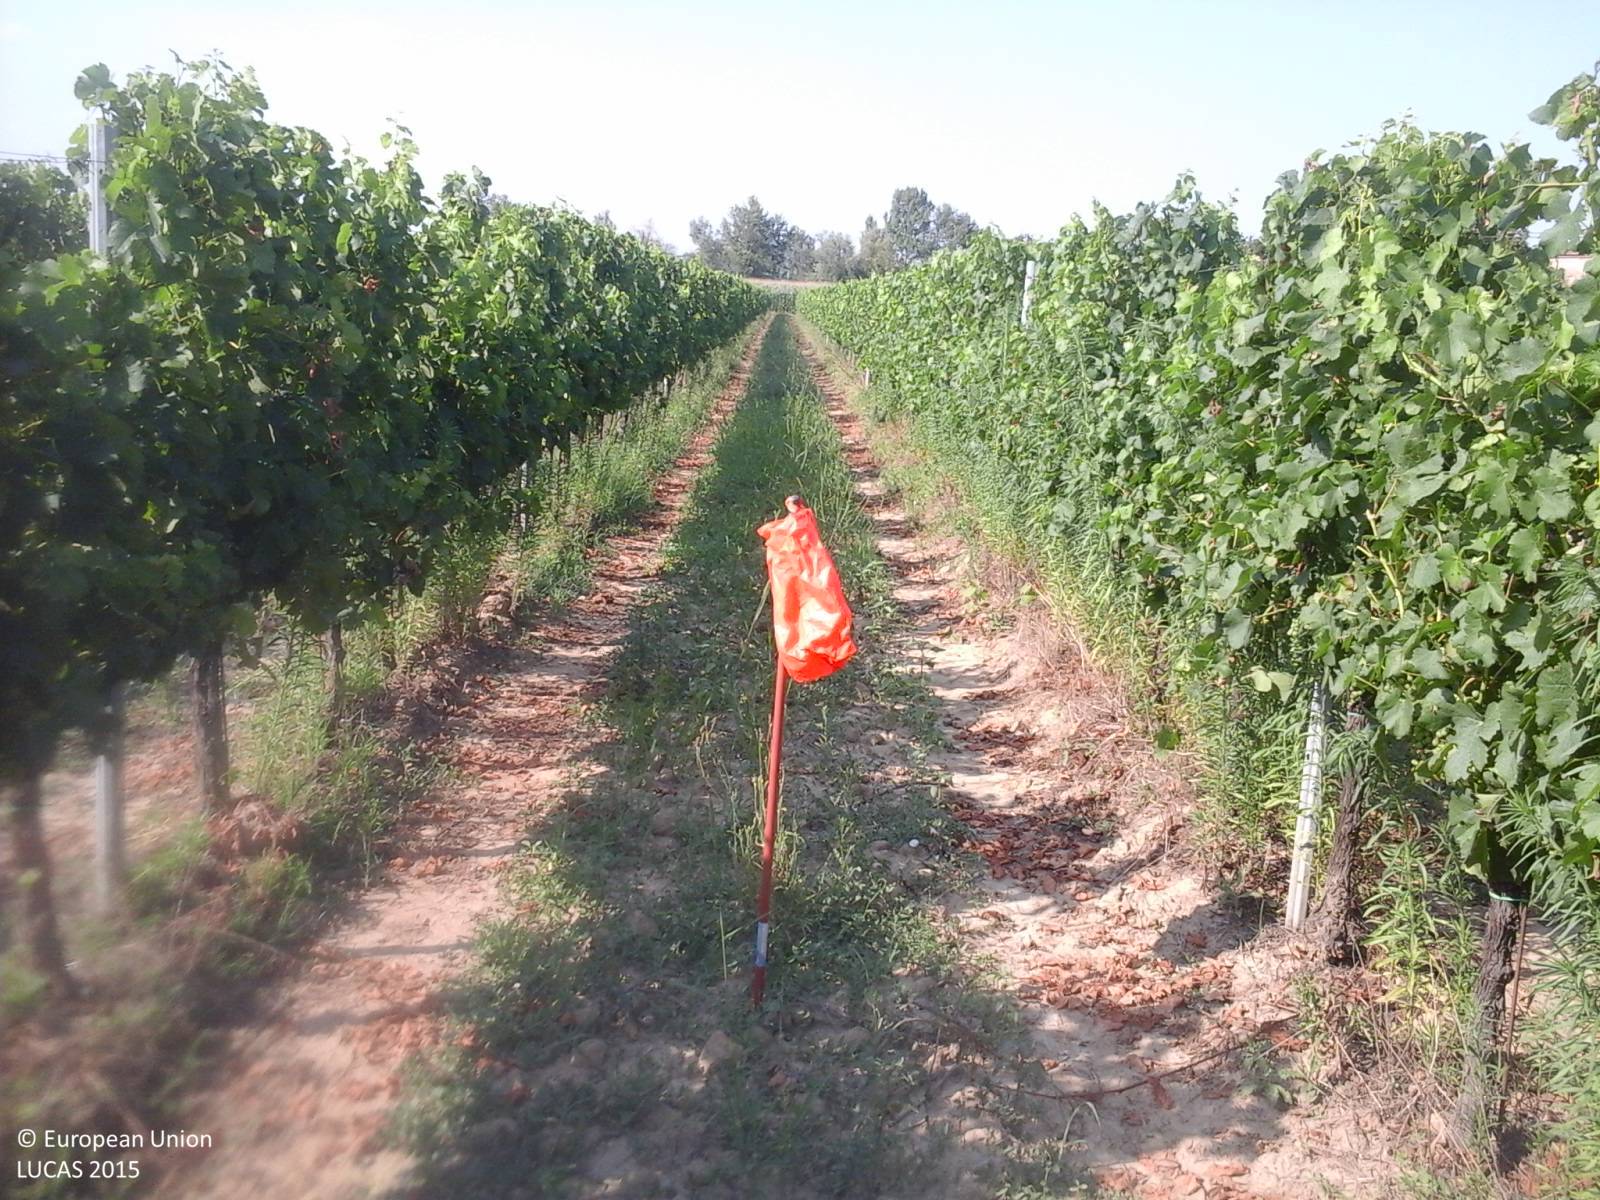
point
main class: Cropland
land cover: Vineyards
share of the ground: 25 - 50 %
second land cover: Grassland without tree/shrub cover
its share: 25 - 50 %
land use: Agriculture (excluding fallow land and kitchen gardens)
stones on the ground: 10 - 25 %
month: July
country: IT
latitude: 43.1424
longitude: 11.8756
